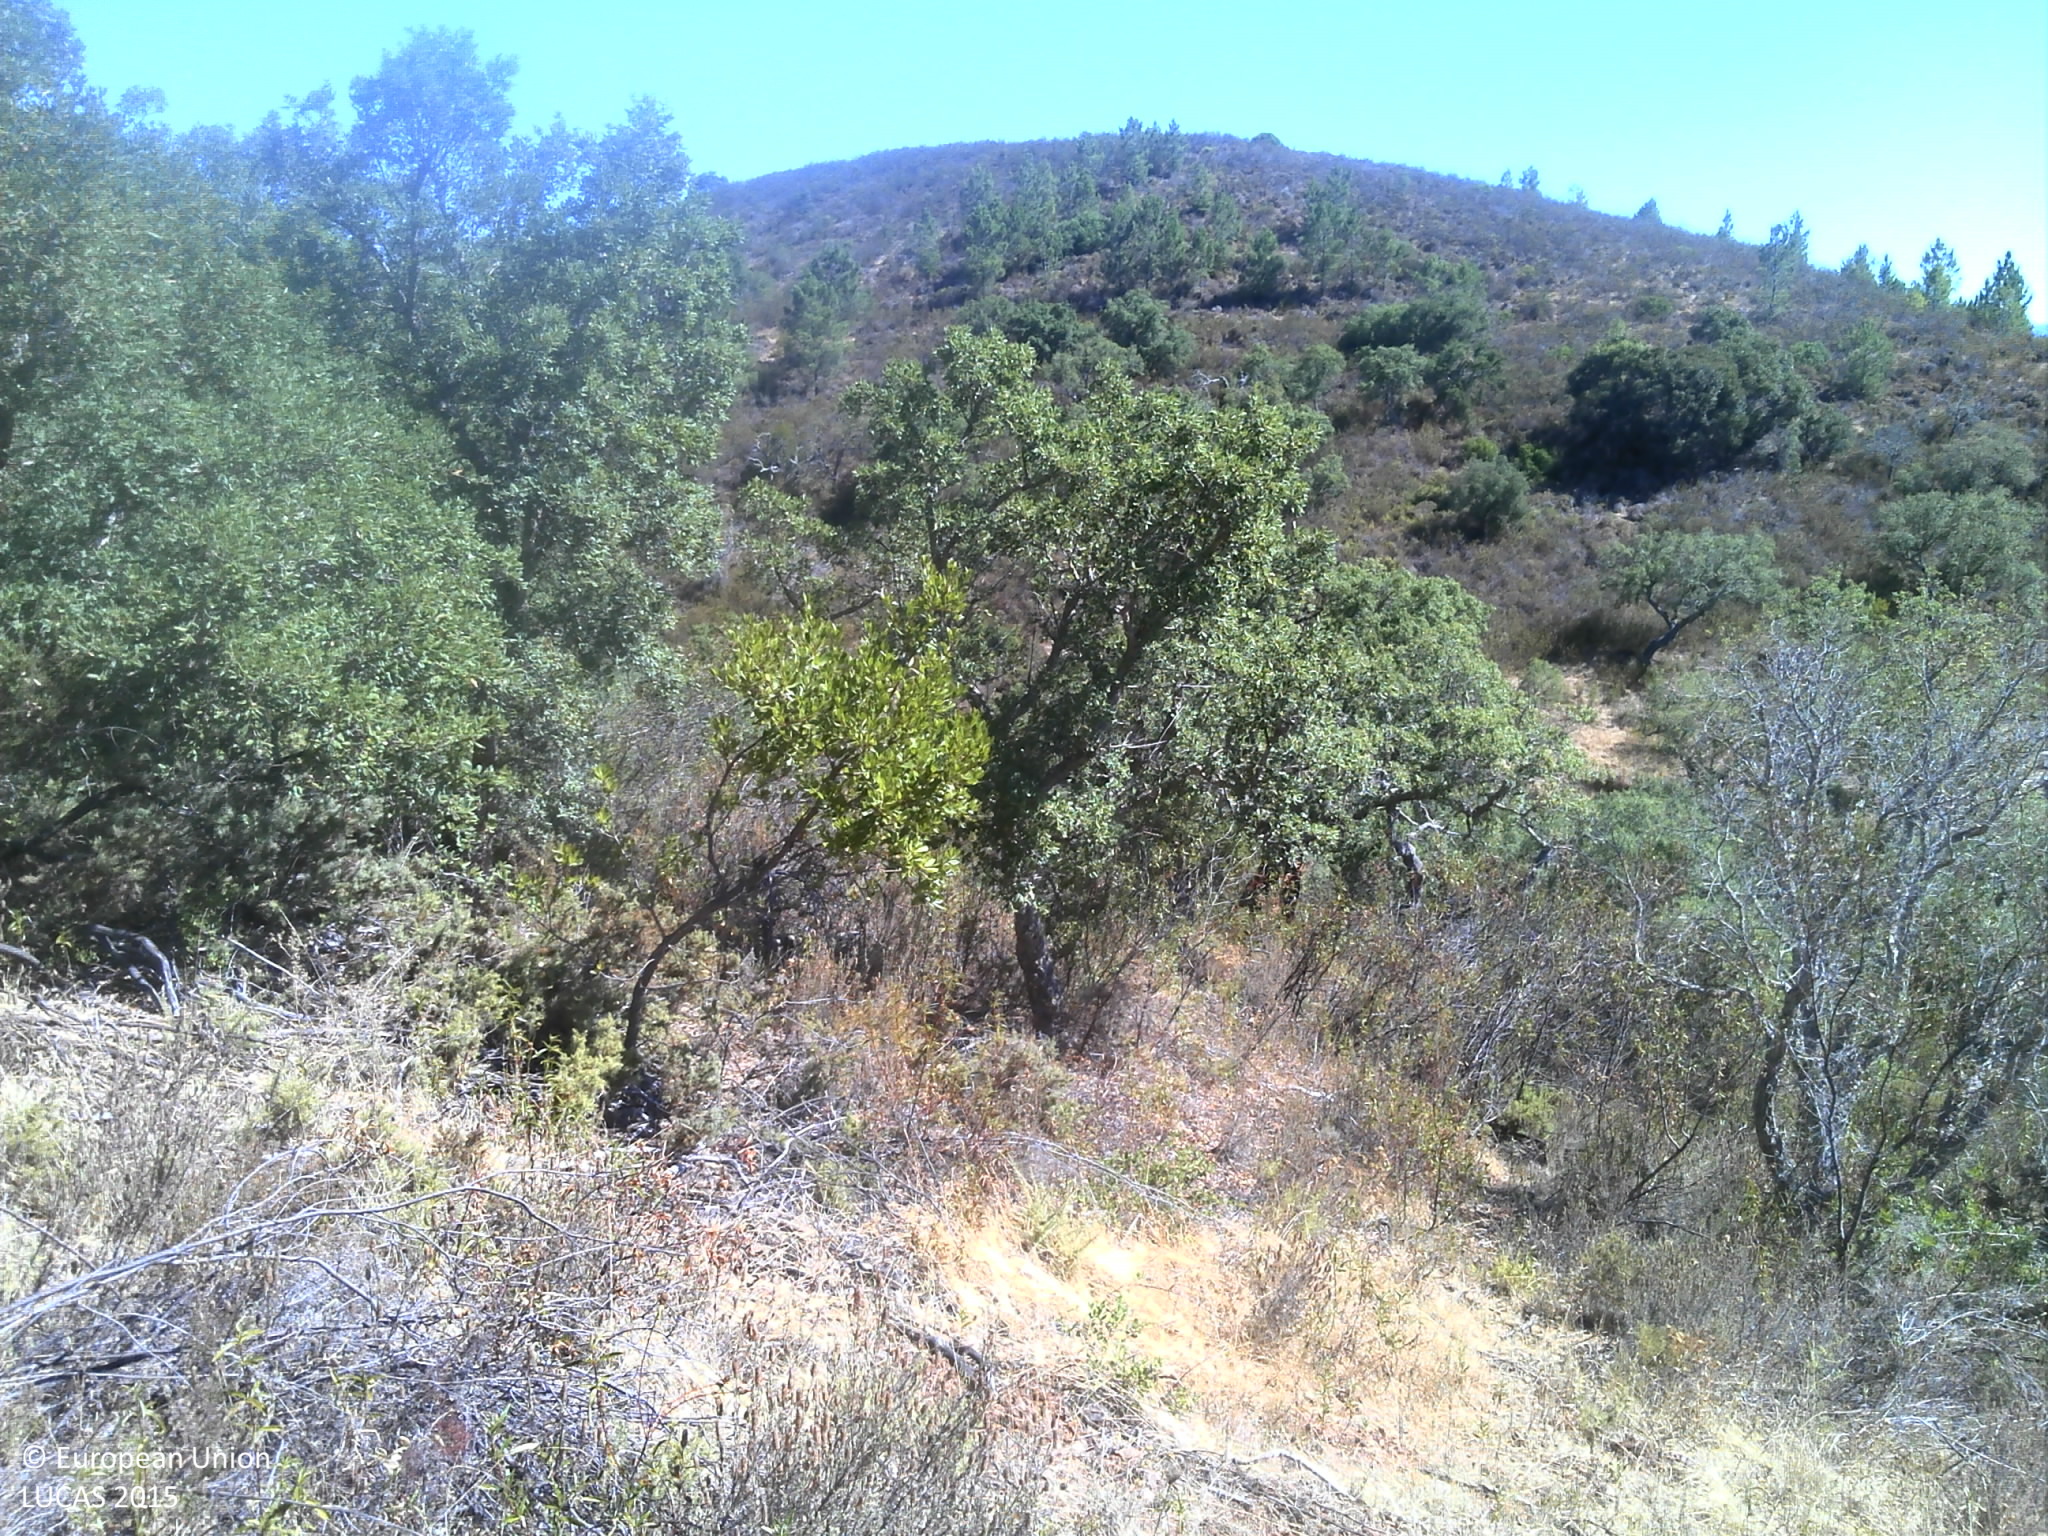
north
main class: Woodland
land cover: Broadleaved woodland
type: broadleaved evergreen forest
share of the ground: 25 - 50 %
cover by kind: shrubs 35 %, unconsolidated bare surface 35 %, broadleaved forest trees 30 %
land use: Forestry
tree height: > 5 m
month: August
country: PT
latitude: 37.1611
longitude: -8.7582
